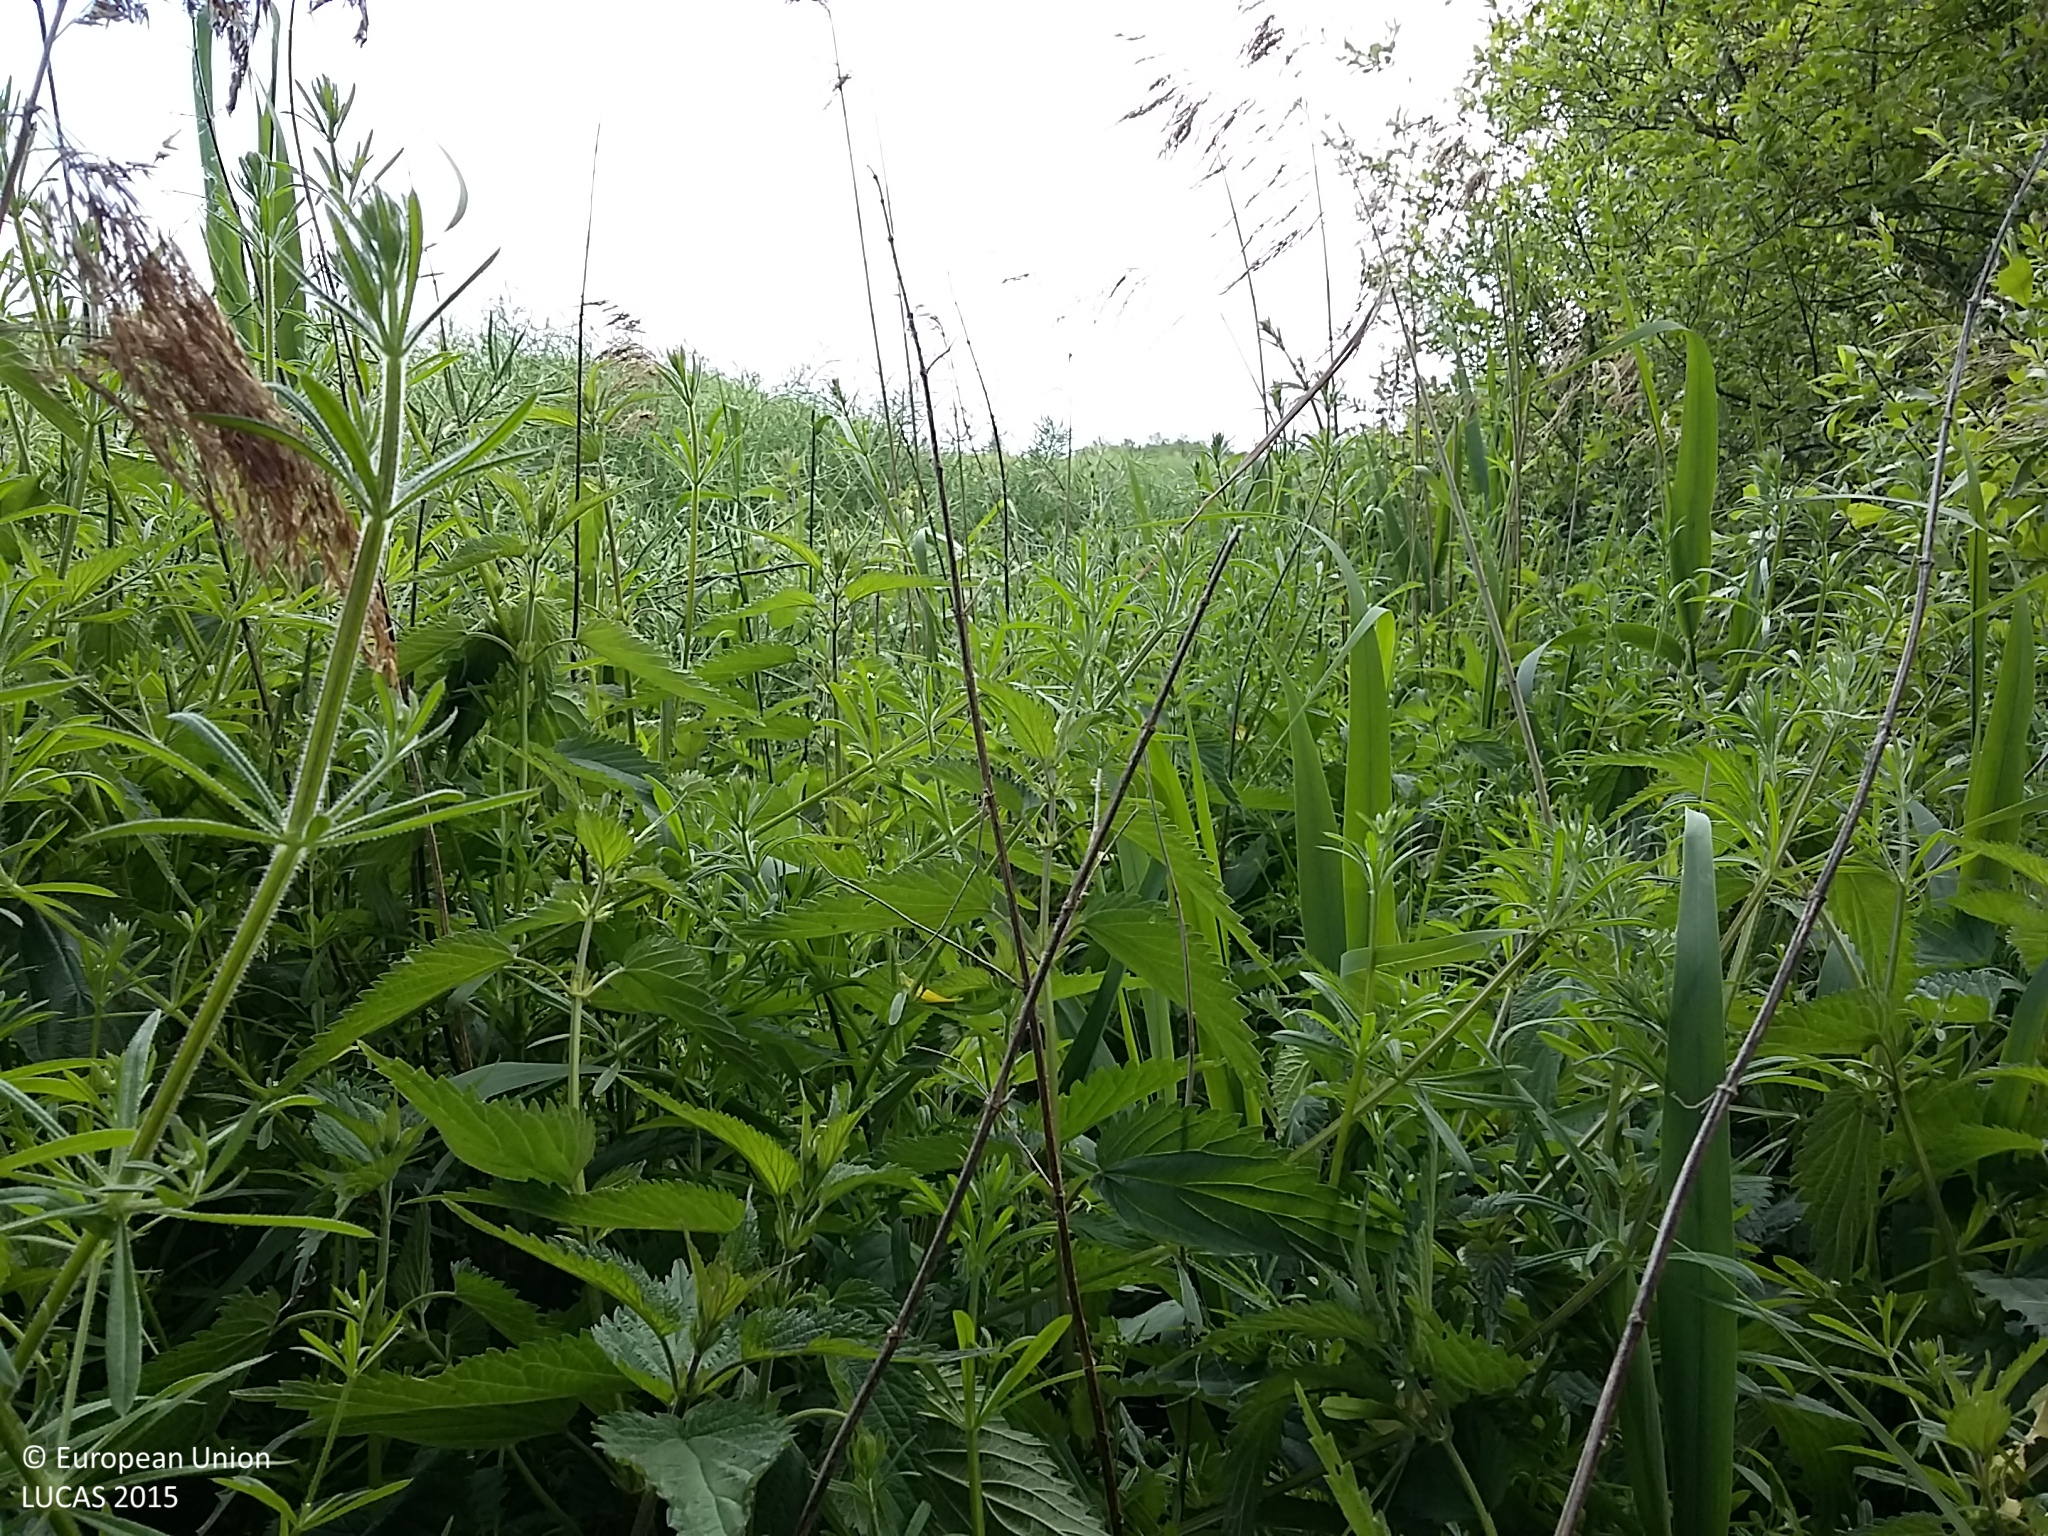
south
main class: Woodland
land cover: Broadleaved woodland
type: mesophytic deciduous forest
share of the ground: > 75 %
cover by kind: broadleaved forest trees 80 %, herbaceous plants 20 %
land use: Semi-natural and natural areas not in use
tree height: > 5 m
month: June
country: DK
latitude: 54.8555
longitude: 10.7316
